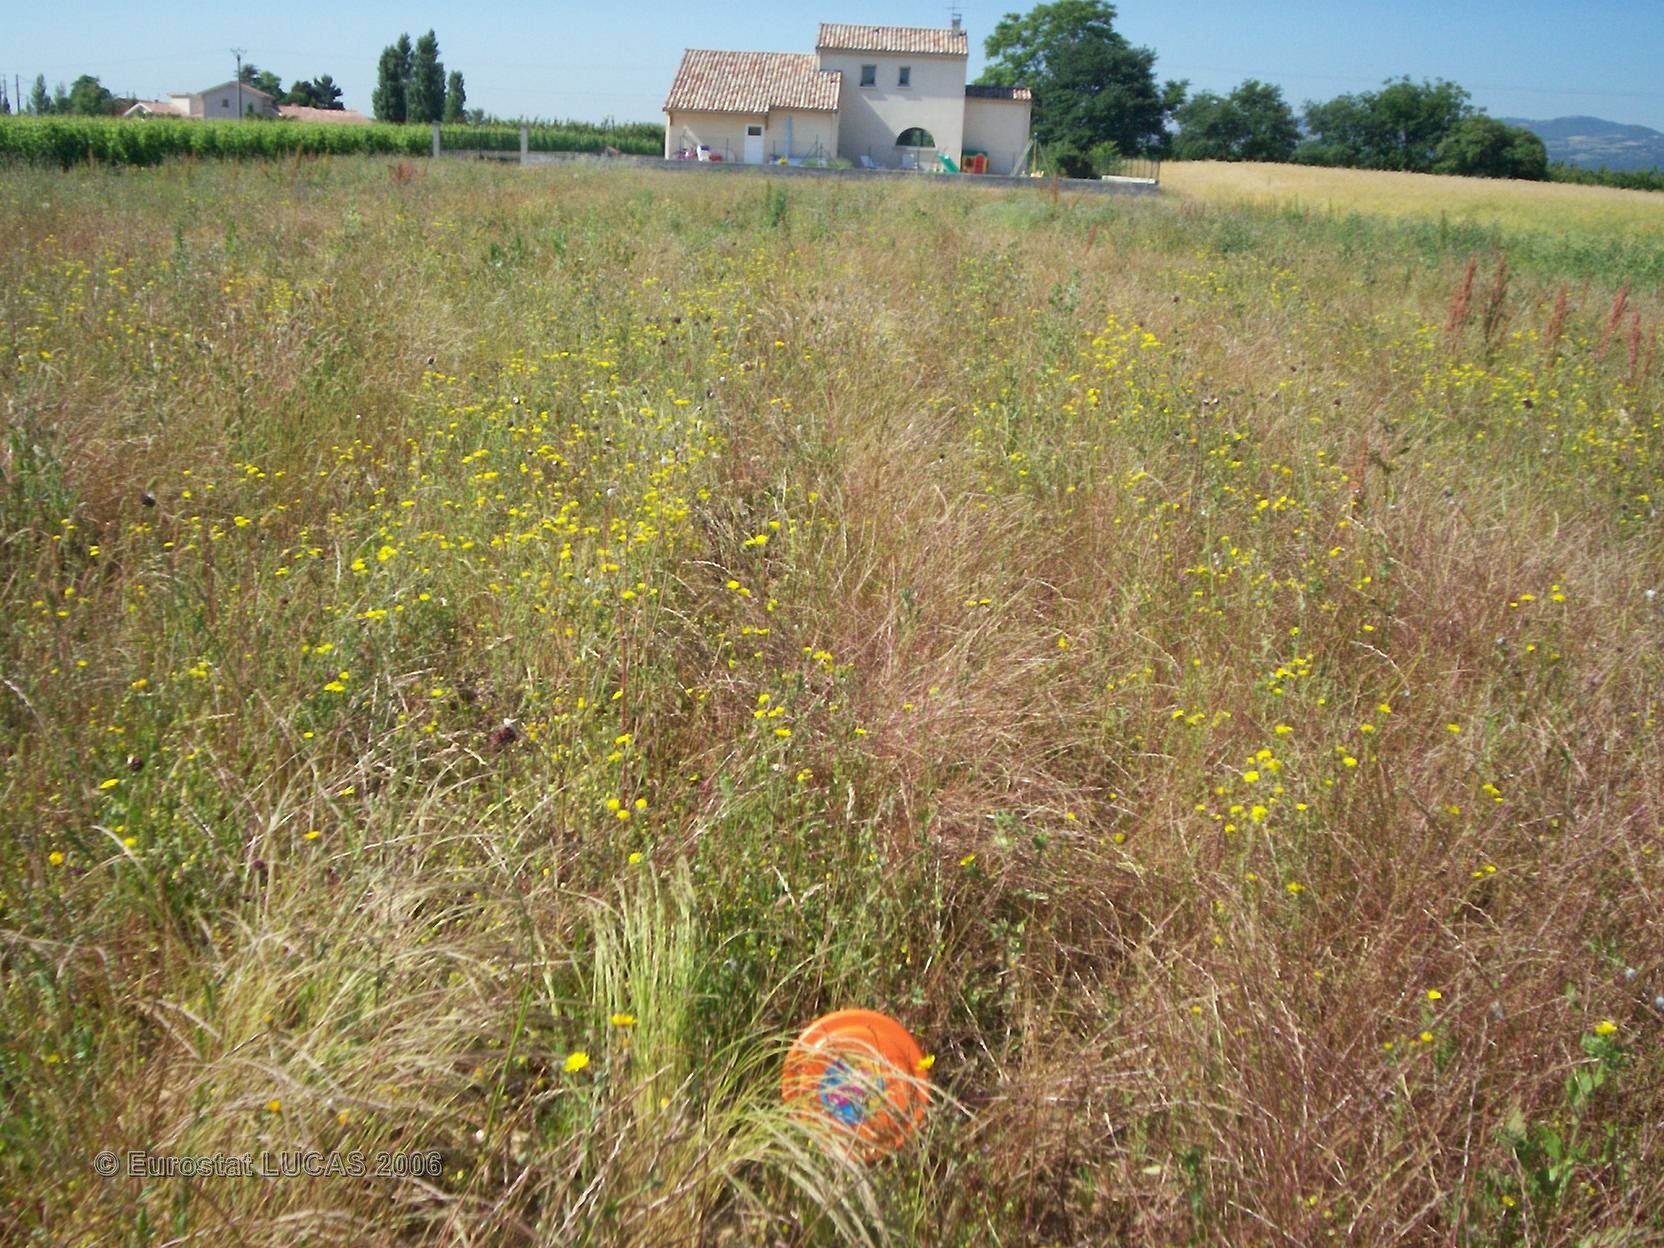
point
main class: Grassland
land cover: Grassland without tree/shrub cover
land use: Fallow land
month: June
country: FR
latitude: 45.0556
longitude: 4.8880
